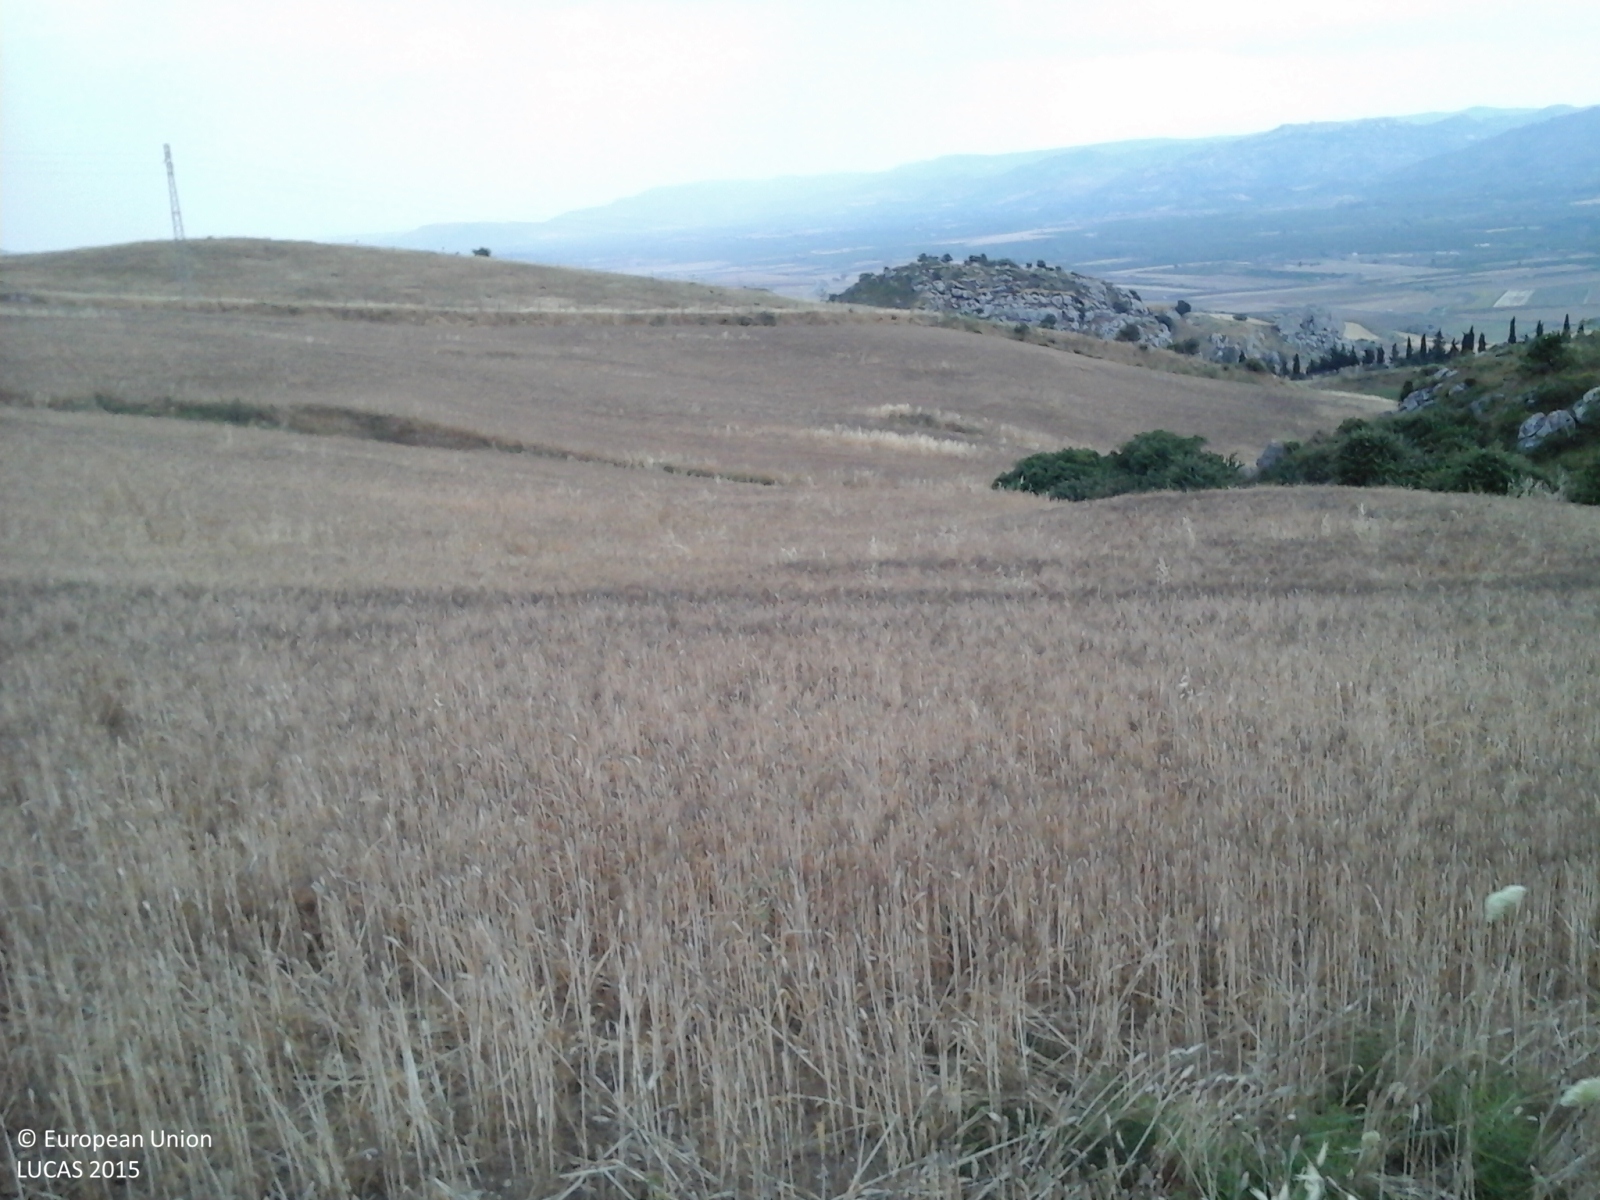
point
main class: Grassland
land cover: Grassland with sparse tree/shrub cover
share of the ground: > 75 %
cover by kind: herbaceous plants 85 %, shrubs 10 %, broadleaved forest trees 5 %
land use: Semi-natural and natural areas not in use
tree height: < 5 m
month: June
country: IT
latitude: 37.2736
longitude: 14.5778
